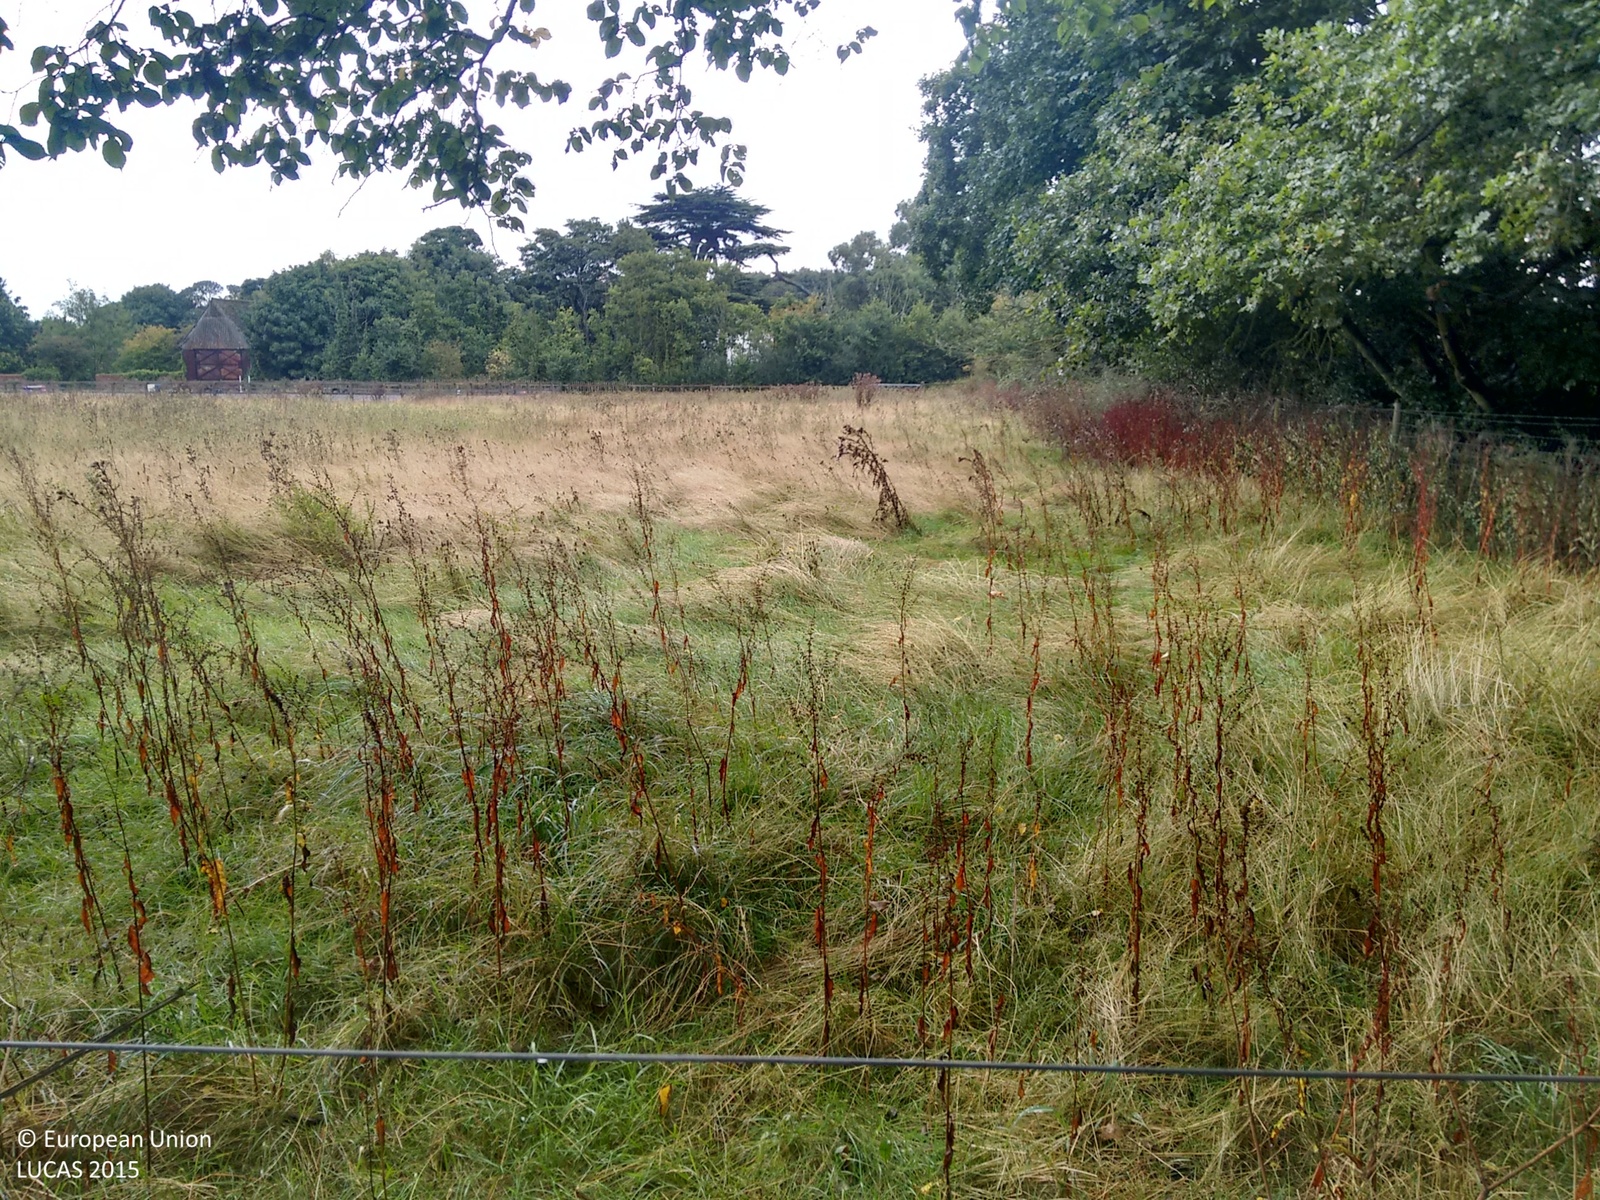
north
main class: Grassland
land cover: Spontaneously vegetated surfaces
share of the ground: > 75 %
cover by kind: herbaceous plants 100 %
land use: Agriculture (excluding fallow land and kitchen gardens)
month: September
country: GB
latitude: 52.2036
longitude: 1.5676
